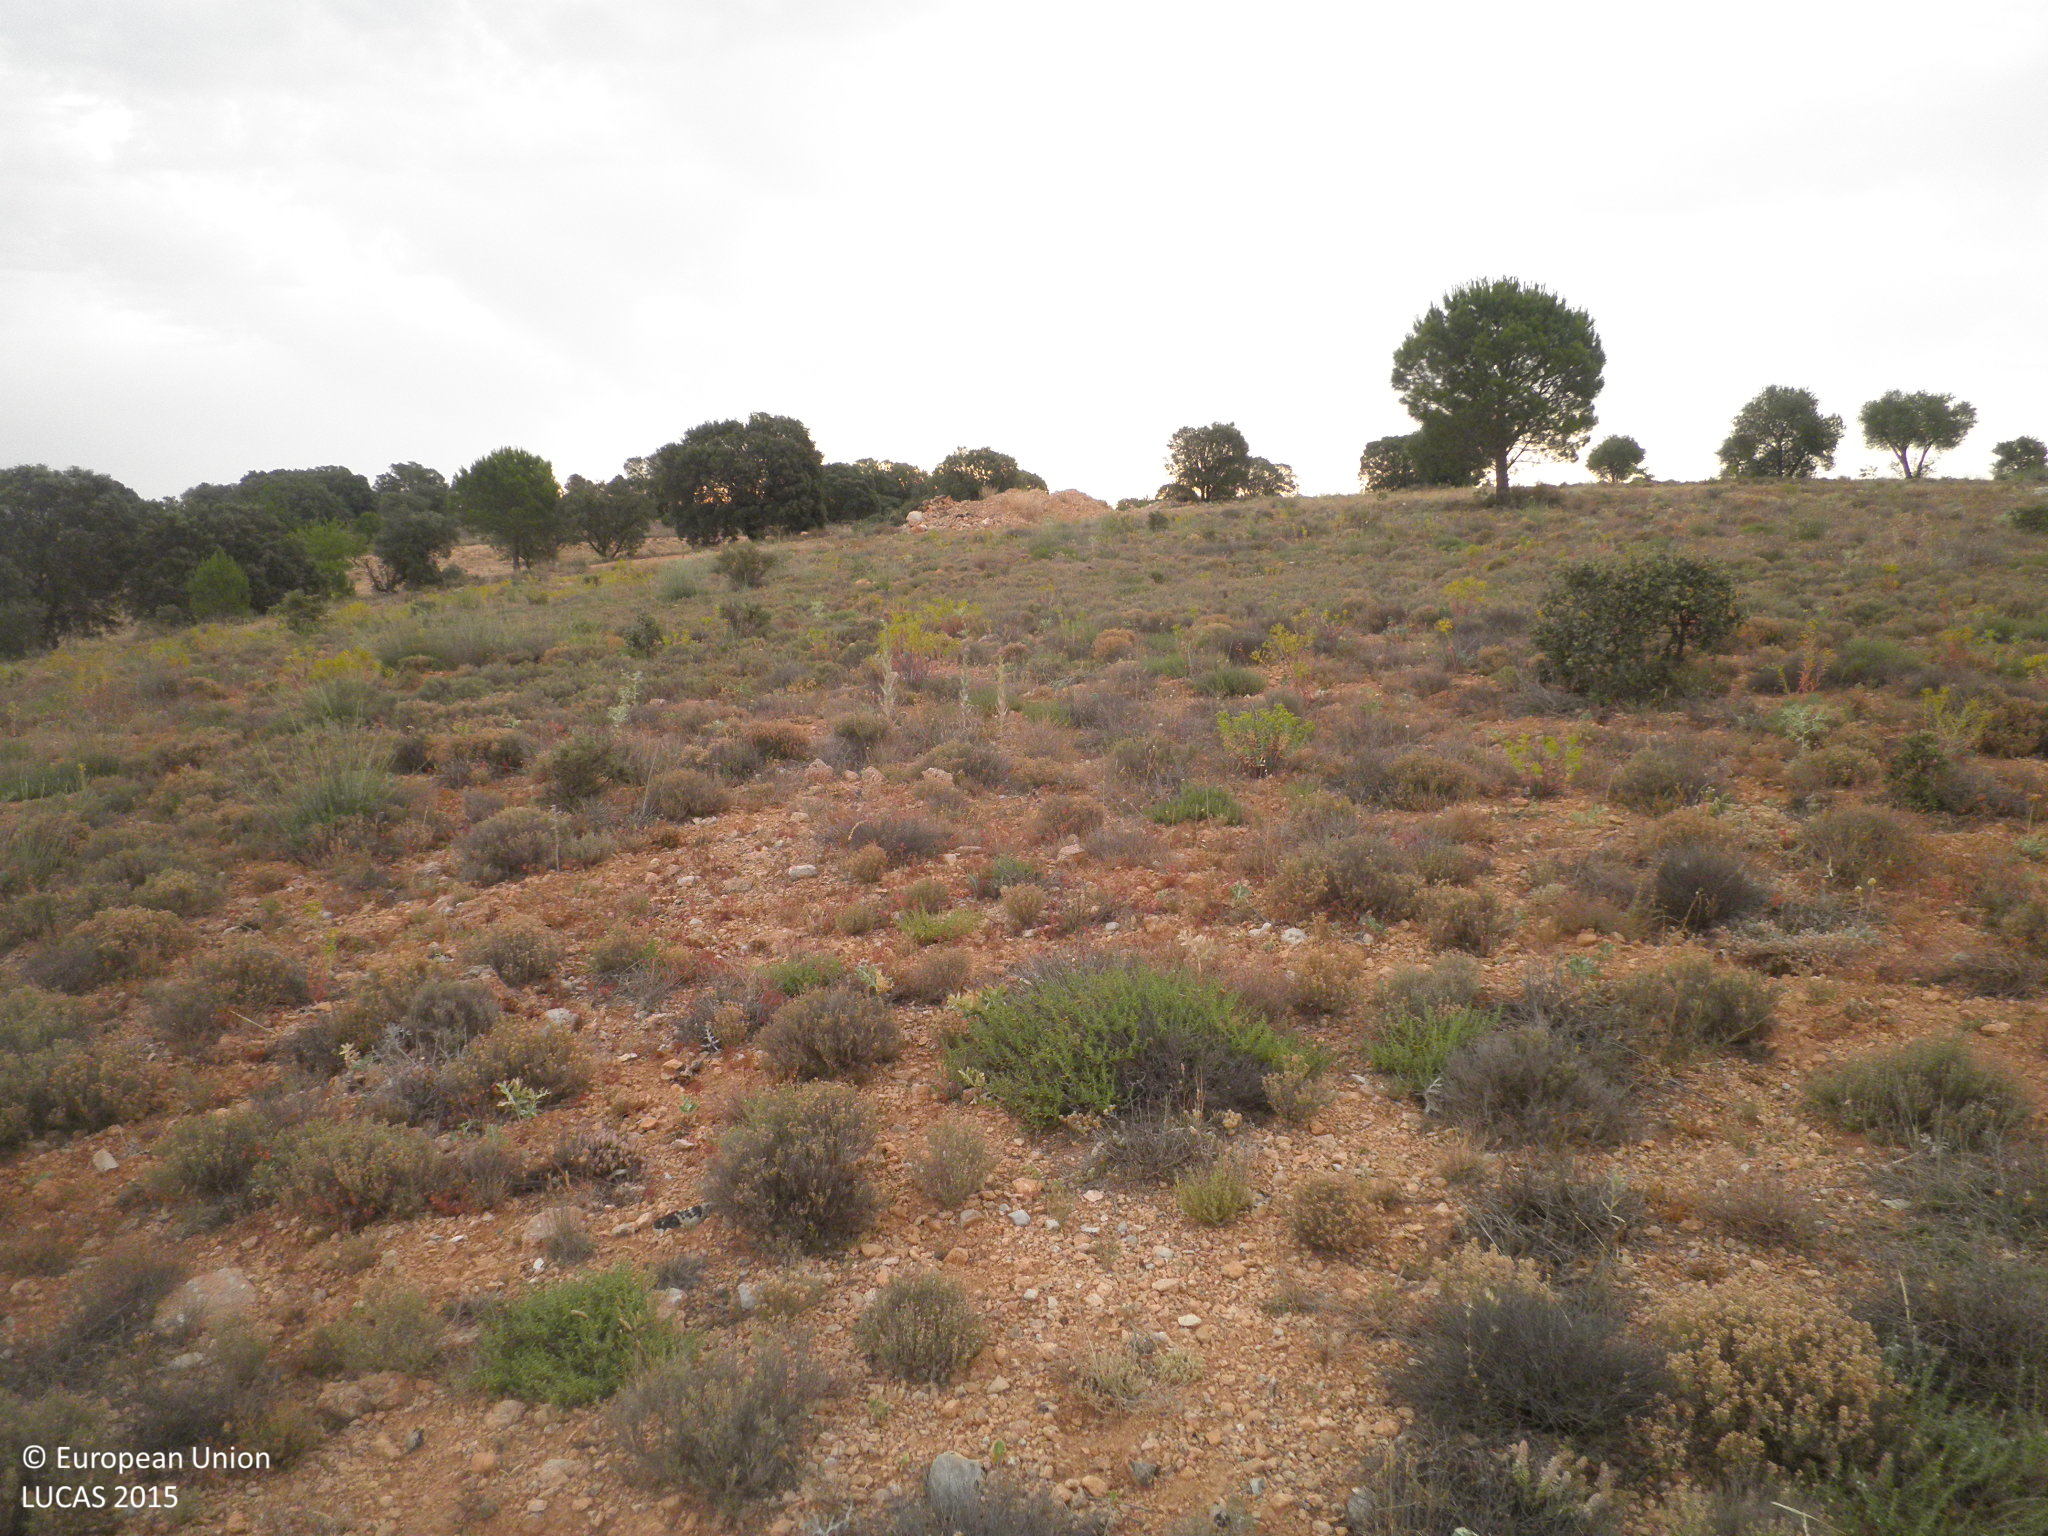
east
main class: Shrubland
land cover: Shrubland without tree cover
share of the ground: 50 - 75 %
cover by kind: shrubs 60 %, unconsolidated bare surface 35 %, herbaceous plants 5 %
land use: Semi-natural and natural areas not in use
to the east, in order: Shrubland without tree cover; Tracks; Olive groves; Tracks; Spontaneously vegetated surfaces; Broadleaved woodland; Tracks; Grassland without tree/shrub cover; Tracks; Barley; Shrubland without tree cover; Tracks; Broadleaved woodland
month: July
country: ES
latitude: 39.5053
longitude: -2.6083
